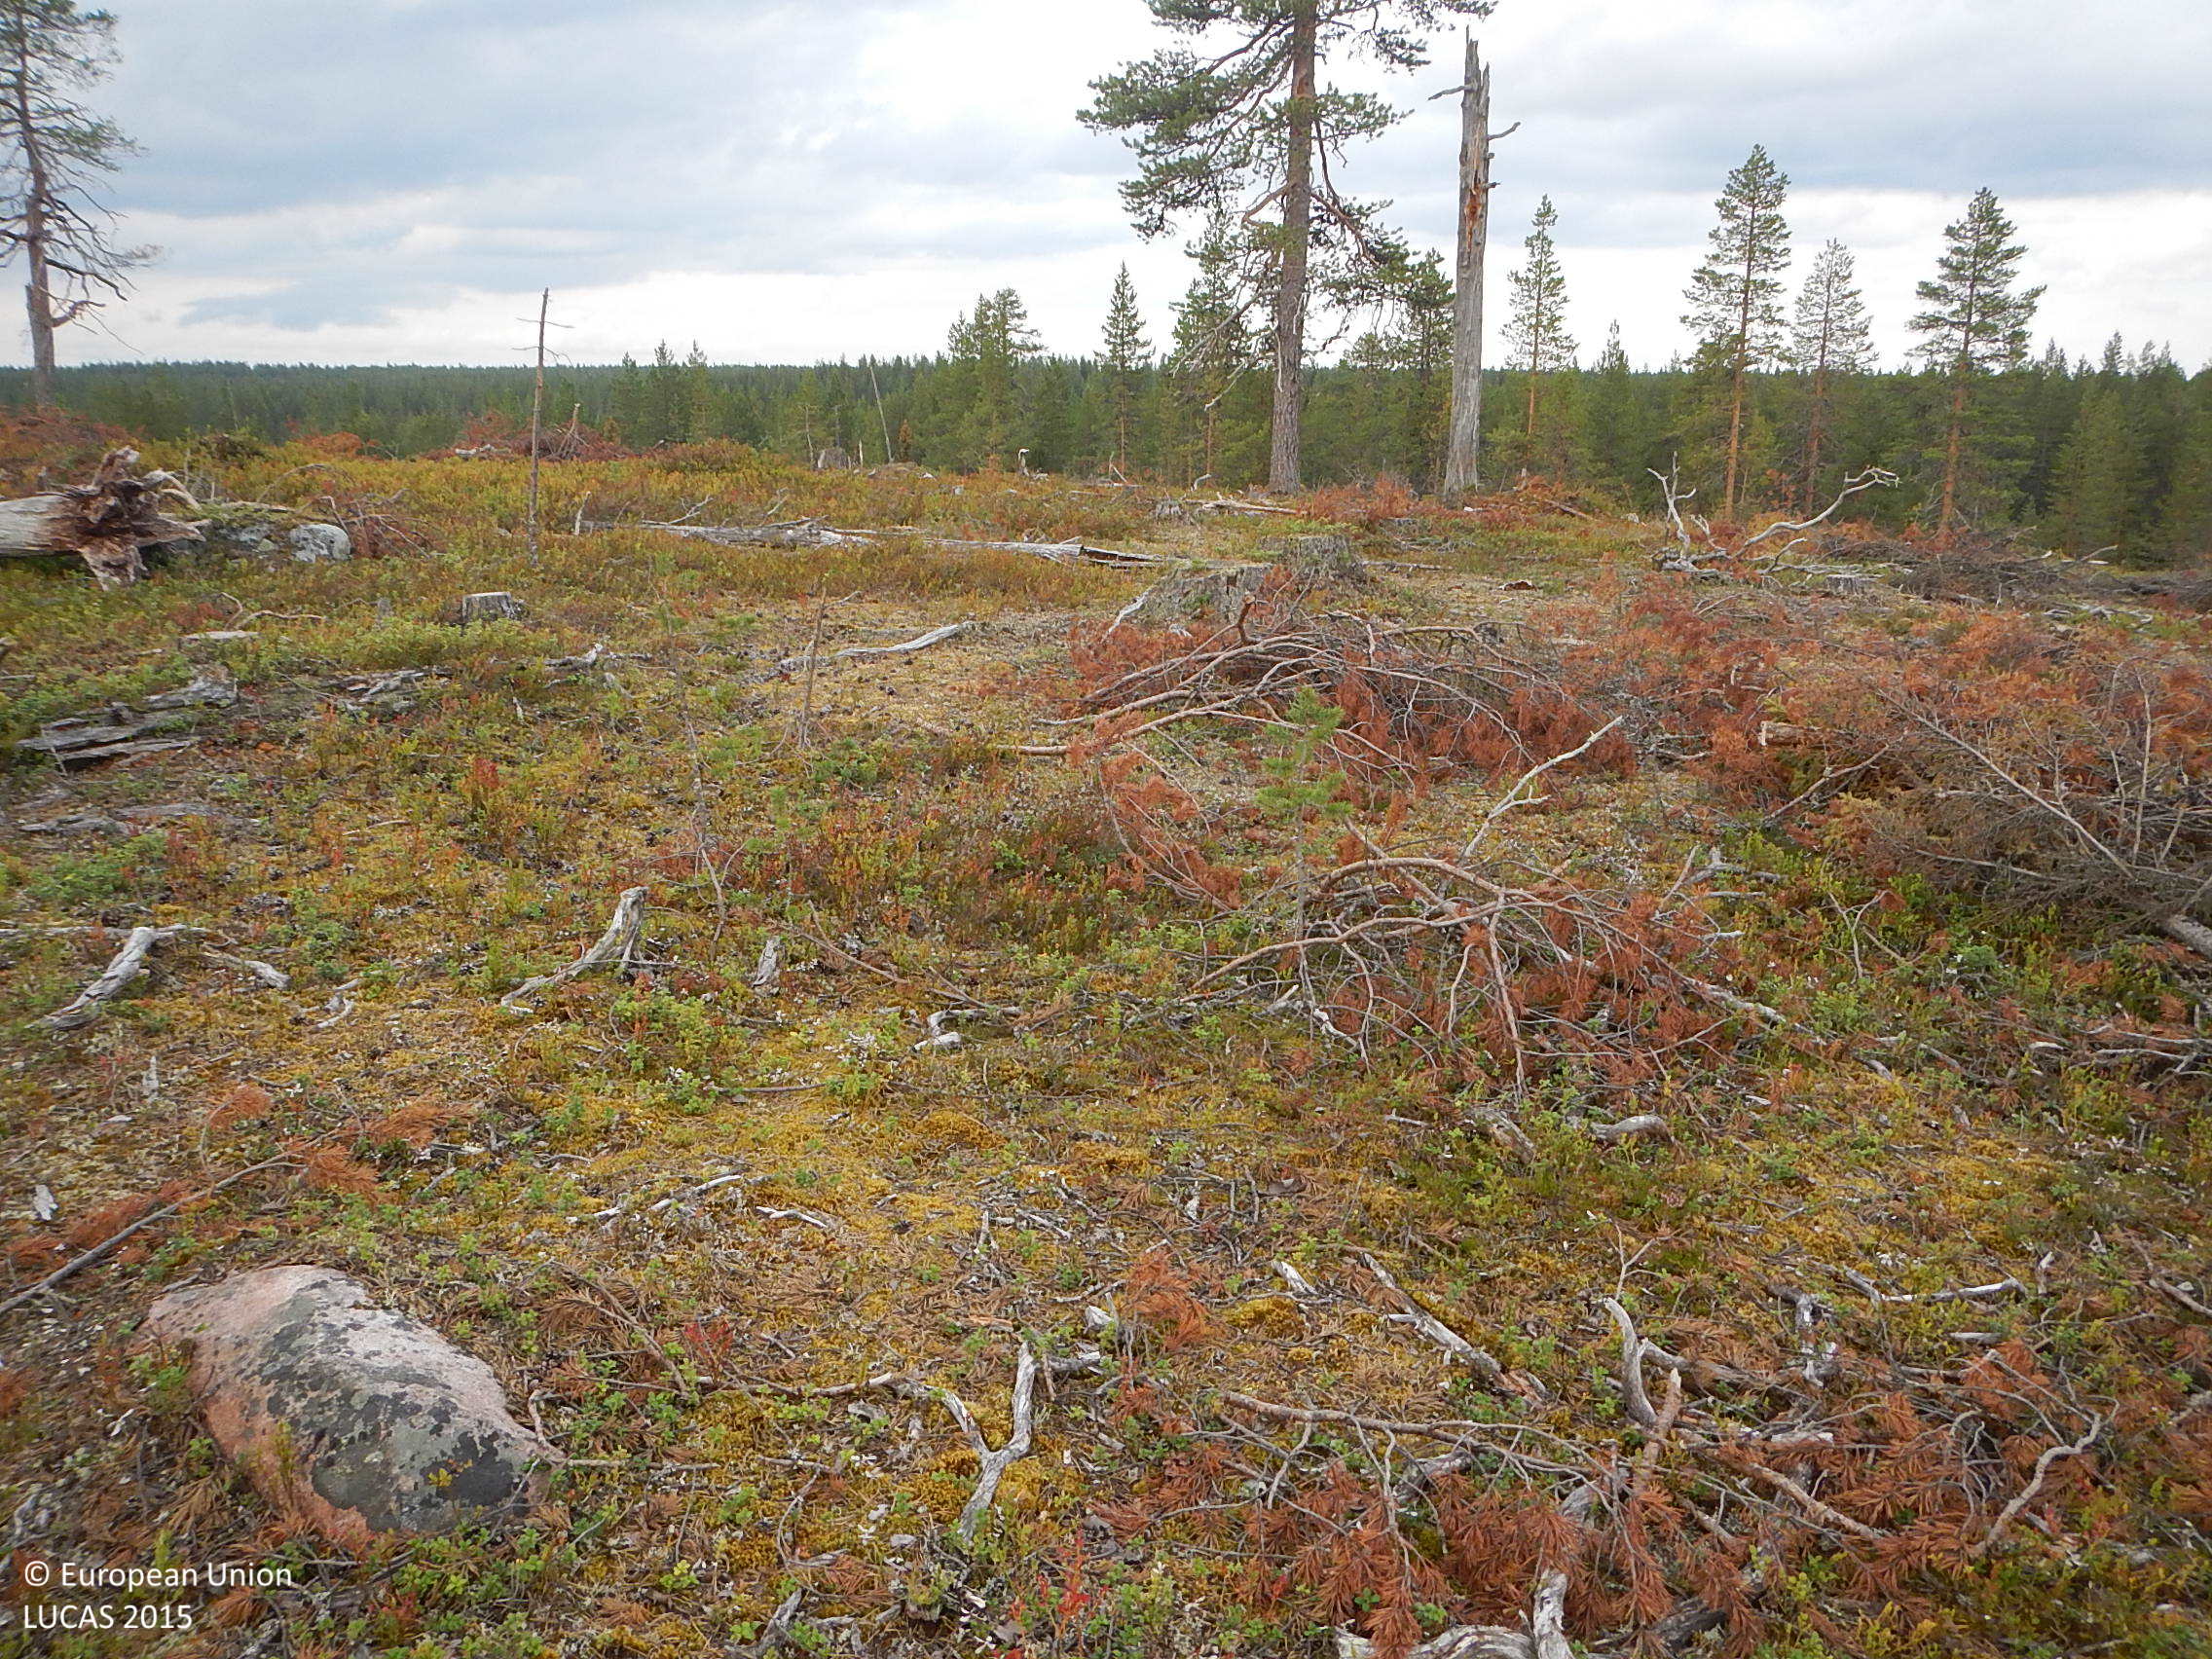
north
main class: Shrubland
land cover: Shrubland with sparse tree cover
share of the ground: > 75 %
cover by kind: shrubs 75 %, lichens and mosses 10 %, unconsolidated bare surface 10 %, coniferous forest trees 5 %
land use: Forestry
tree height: < 5 m
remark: Clear cut
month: August
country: FI
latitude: 66.0571
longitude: 27.8645
